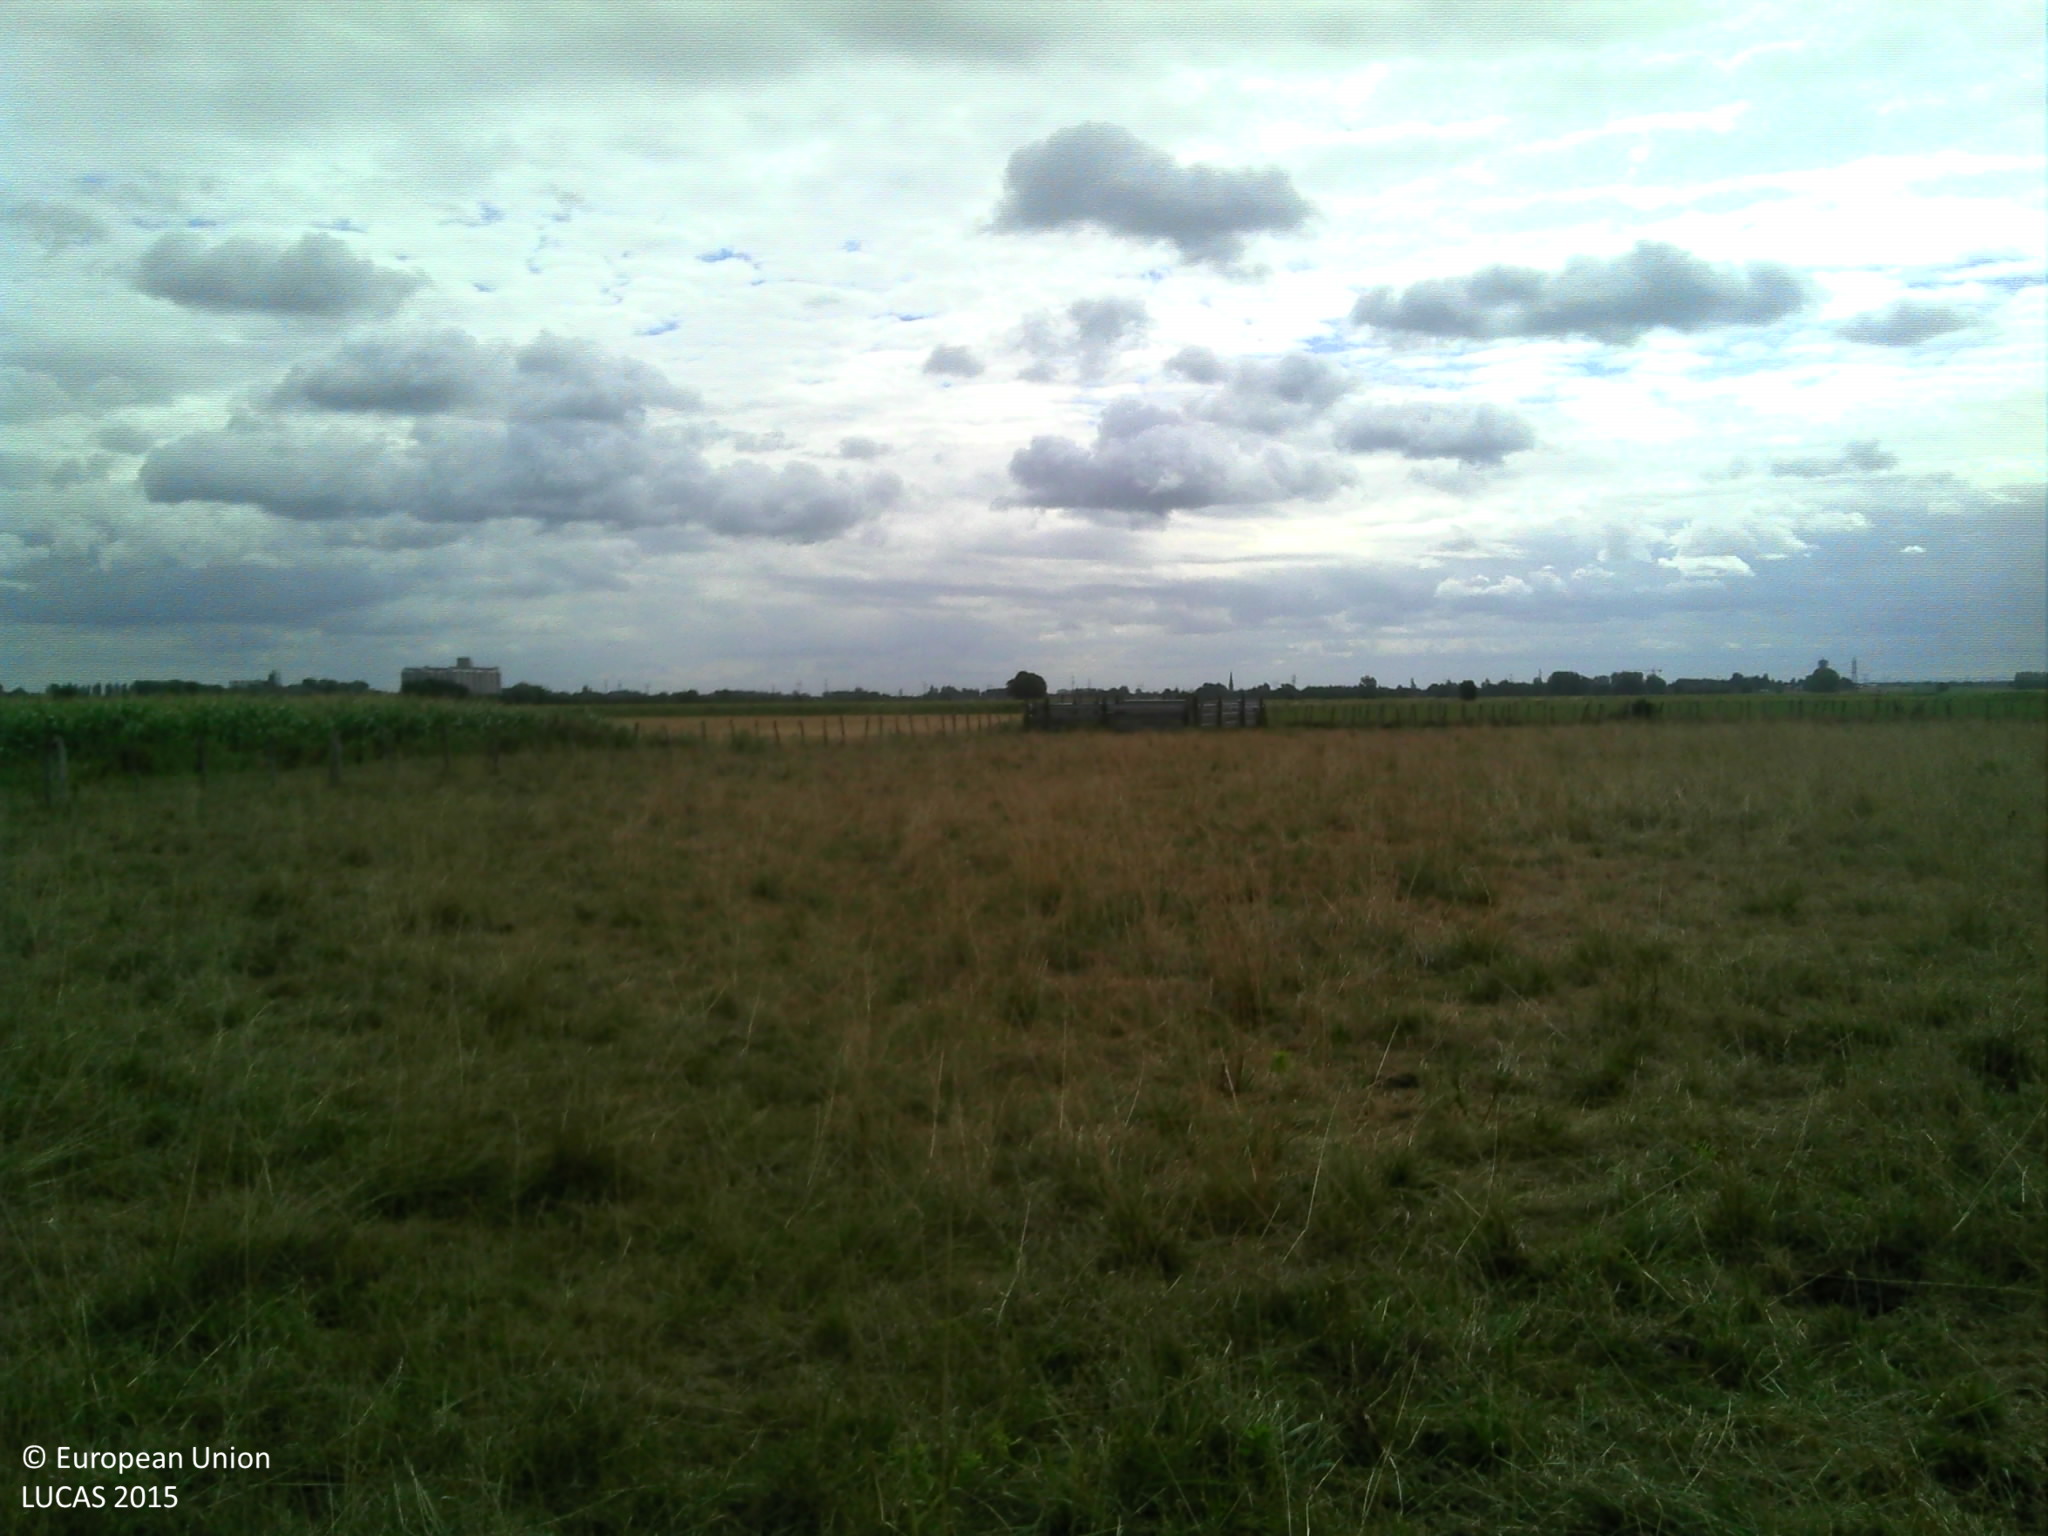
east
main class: Grassland
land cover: Grassland without tree/shrub cover
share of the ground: > 75 %
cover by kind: herbaceous plants 100 %
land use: Agriculture (excluding fallow land and kitchen gardens)
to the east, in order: Grassland without tree/shrub cover; Fences; Grass margins; Tracks; Ditches and canals; Other bare soil; Tracks; Ditches and canals; Maize
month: July
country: FR
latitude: 46.8839
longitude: 5.0015
